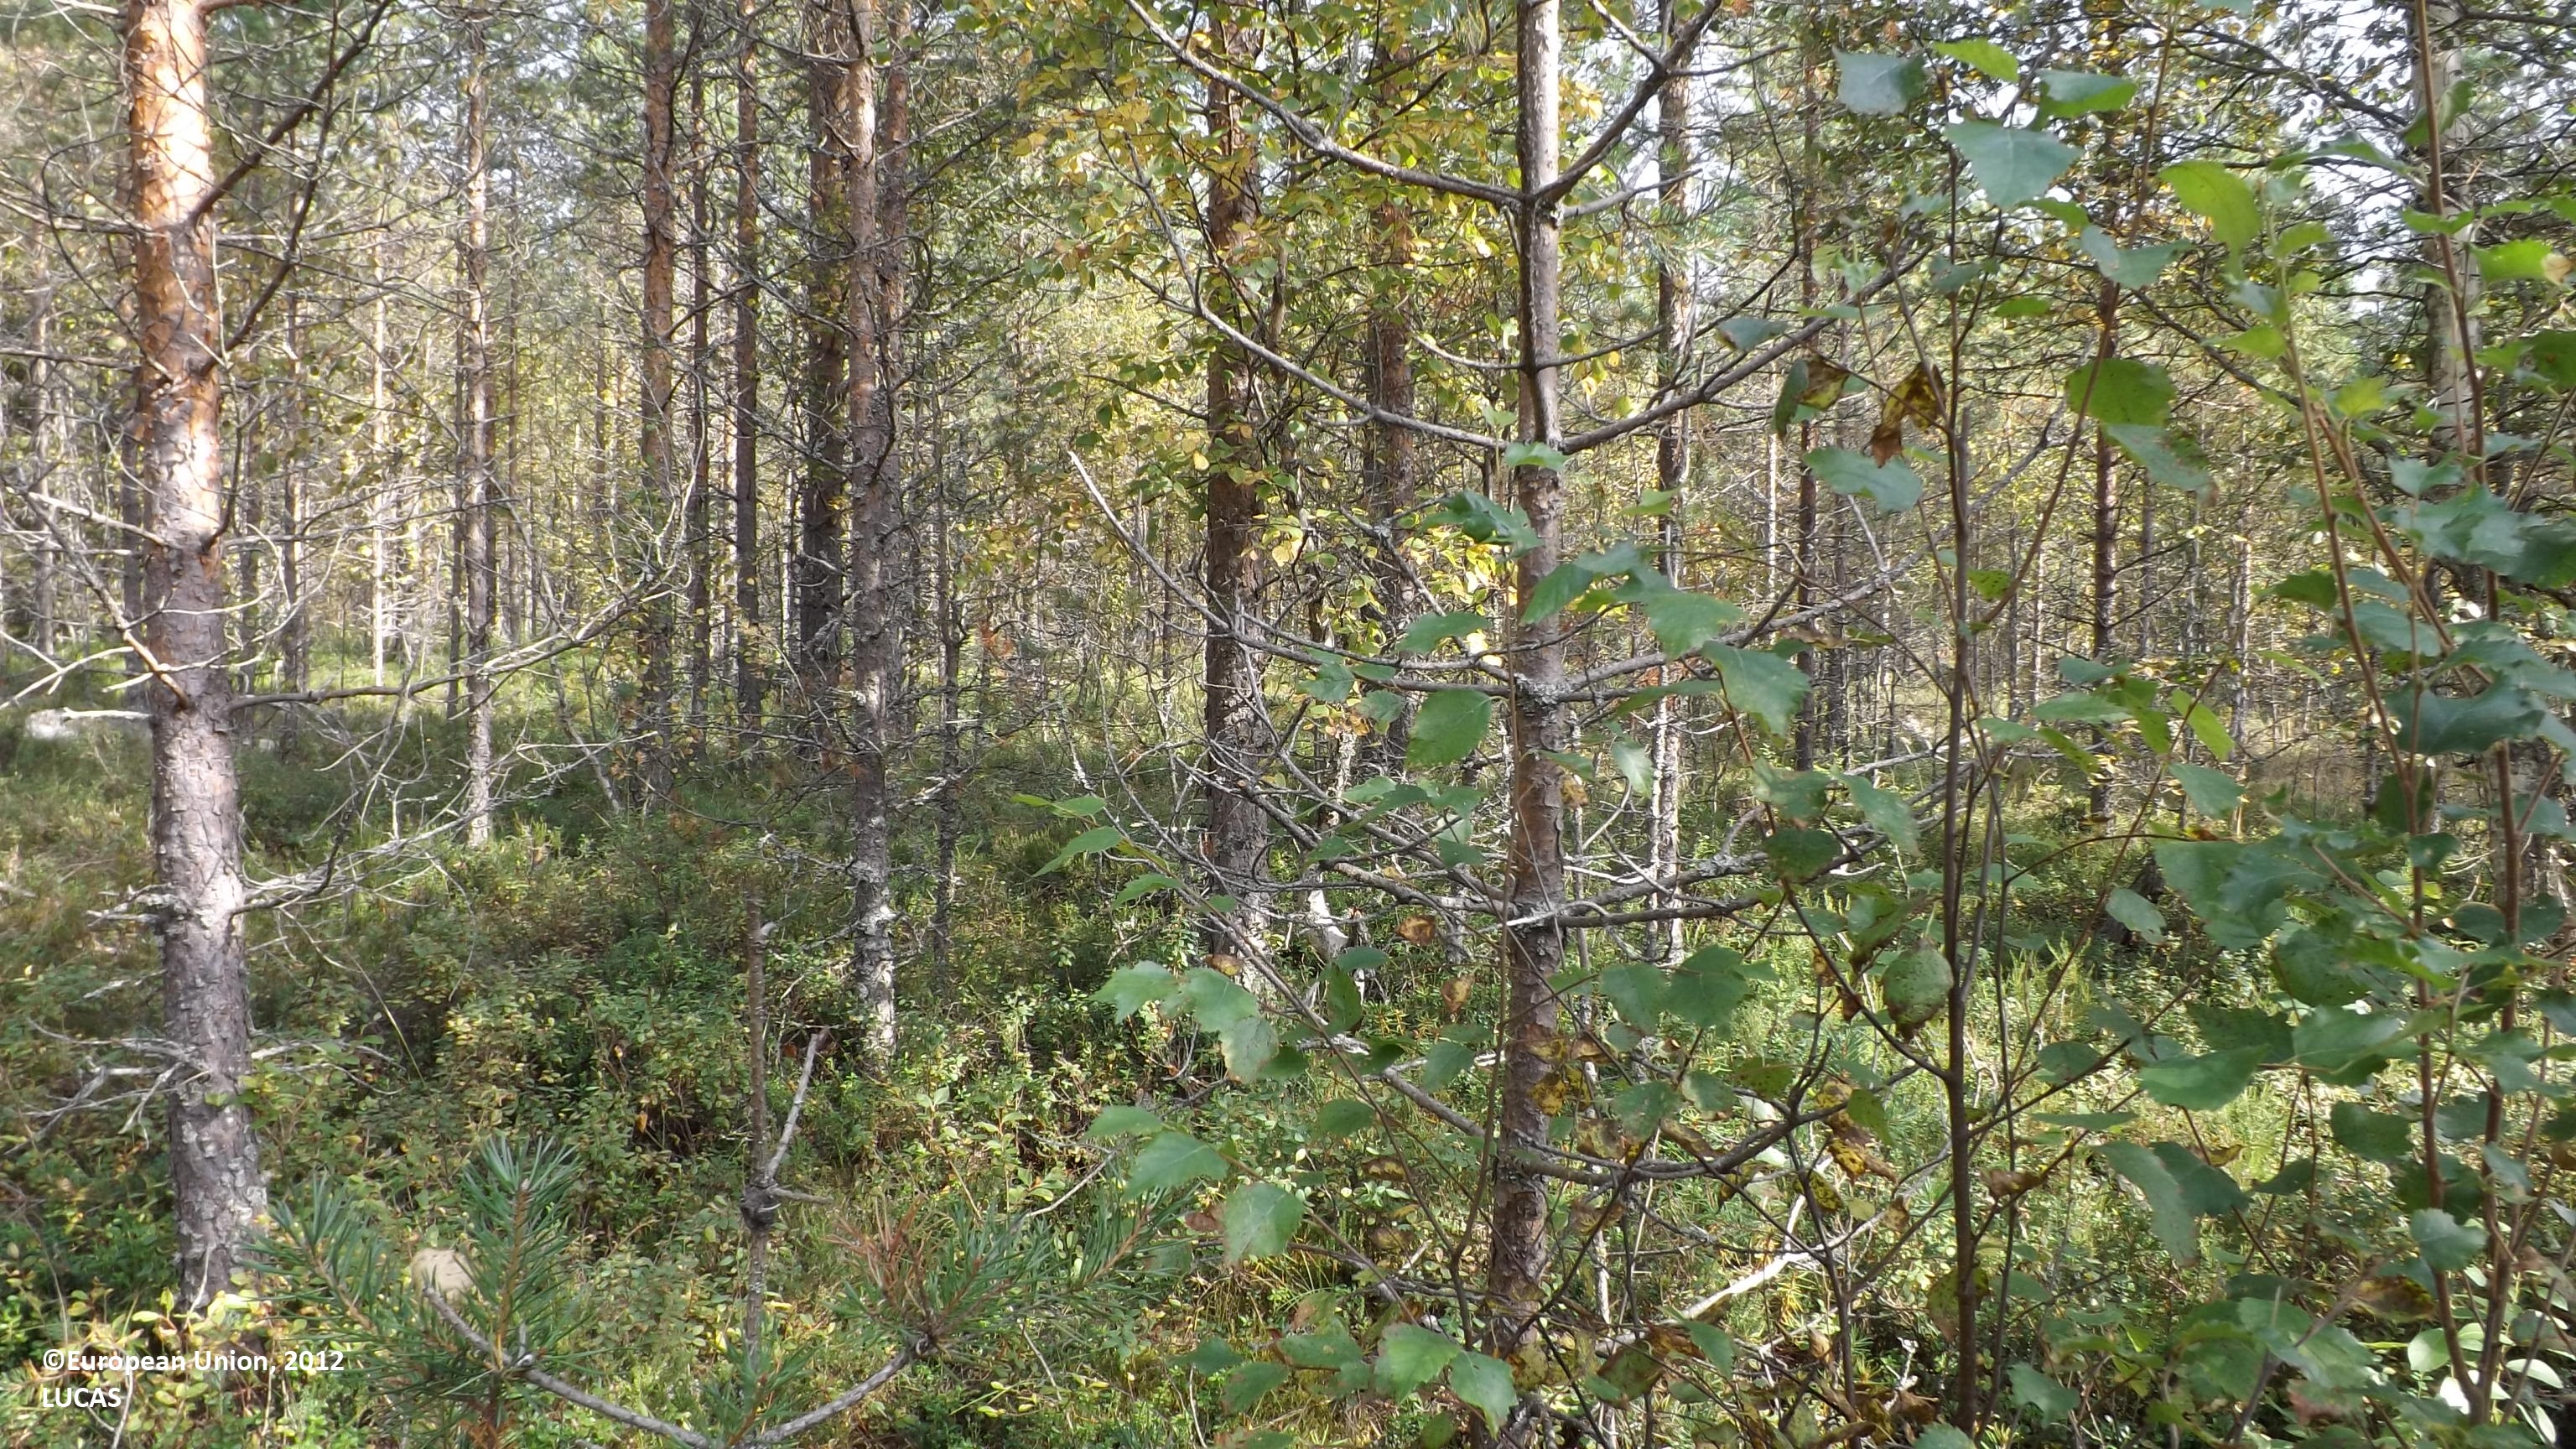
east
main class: Woodland
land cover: Pine dominated coniferous woodland
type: boreal forest
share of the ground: 50 - 75 %
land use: Forestry
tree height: > 5 m
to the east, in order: Pine dominated coniferous woodland; Pine dominated mixed woodland; Broadleaved woodland; Pine dominated mixed woodland; Tracks; Pine dominated mixed woodland; Ditches and canals; Pine dominated mixed woodland; Ditches and canals; Pine dominated mixed woodland; Ditches and canals; Pine dominated mixed woodland; Pine dominated coniferous woodland
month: August
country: FI
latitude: 63.7347
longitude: 23.6115
